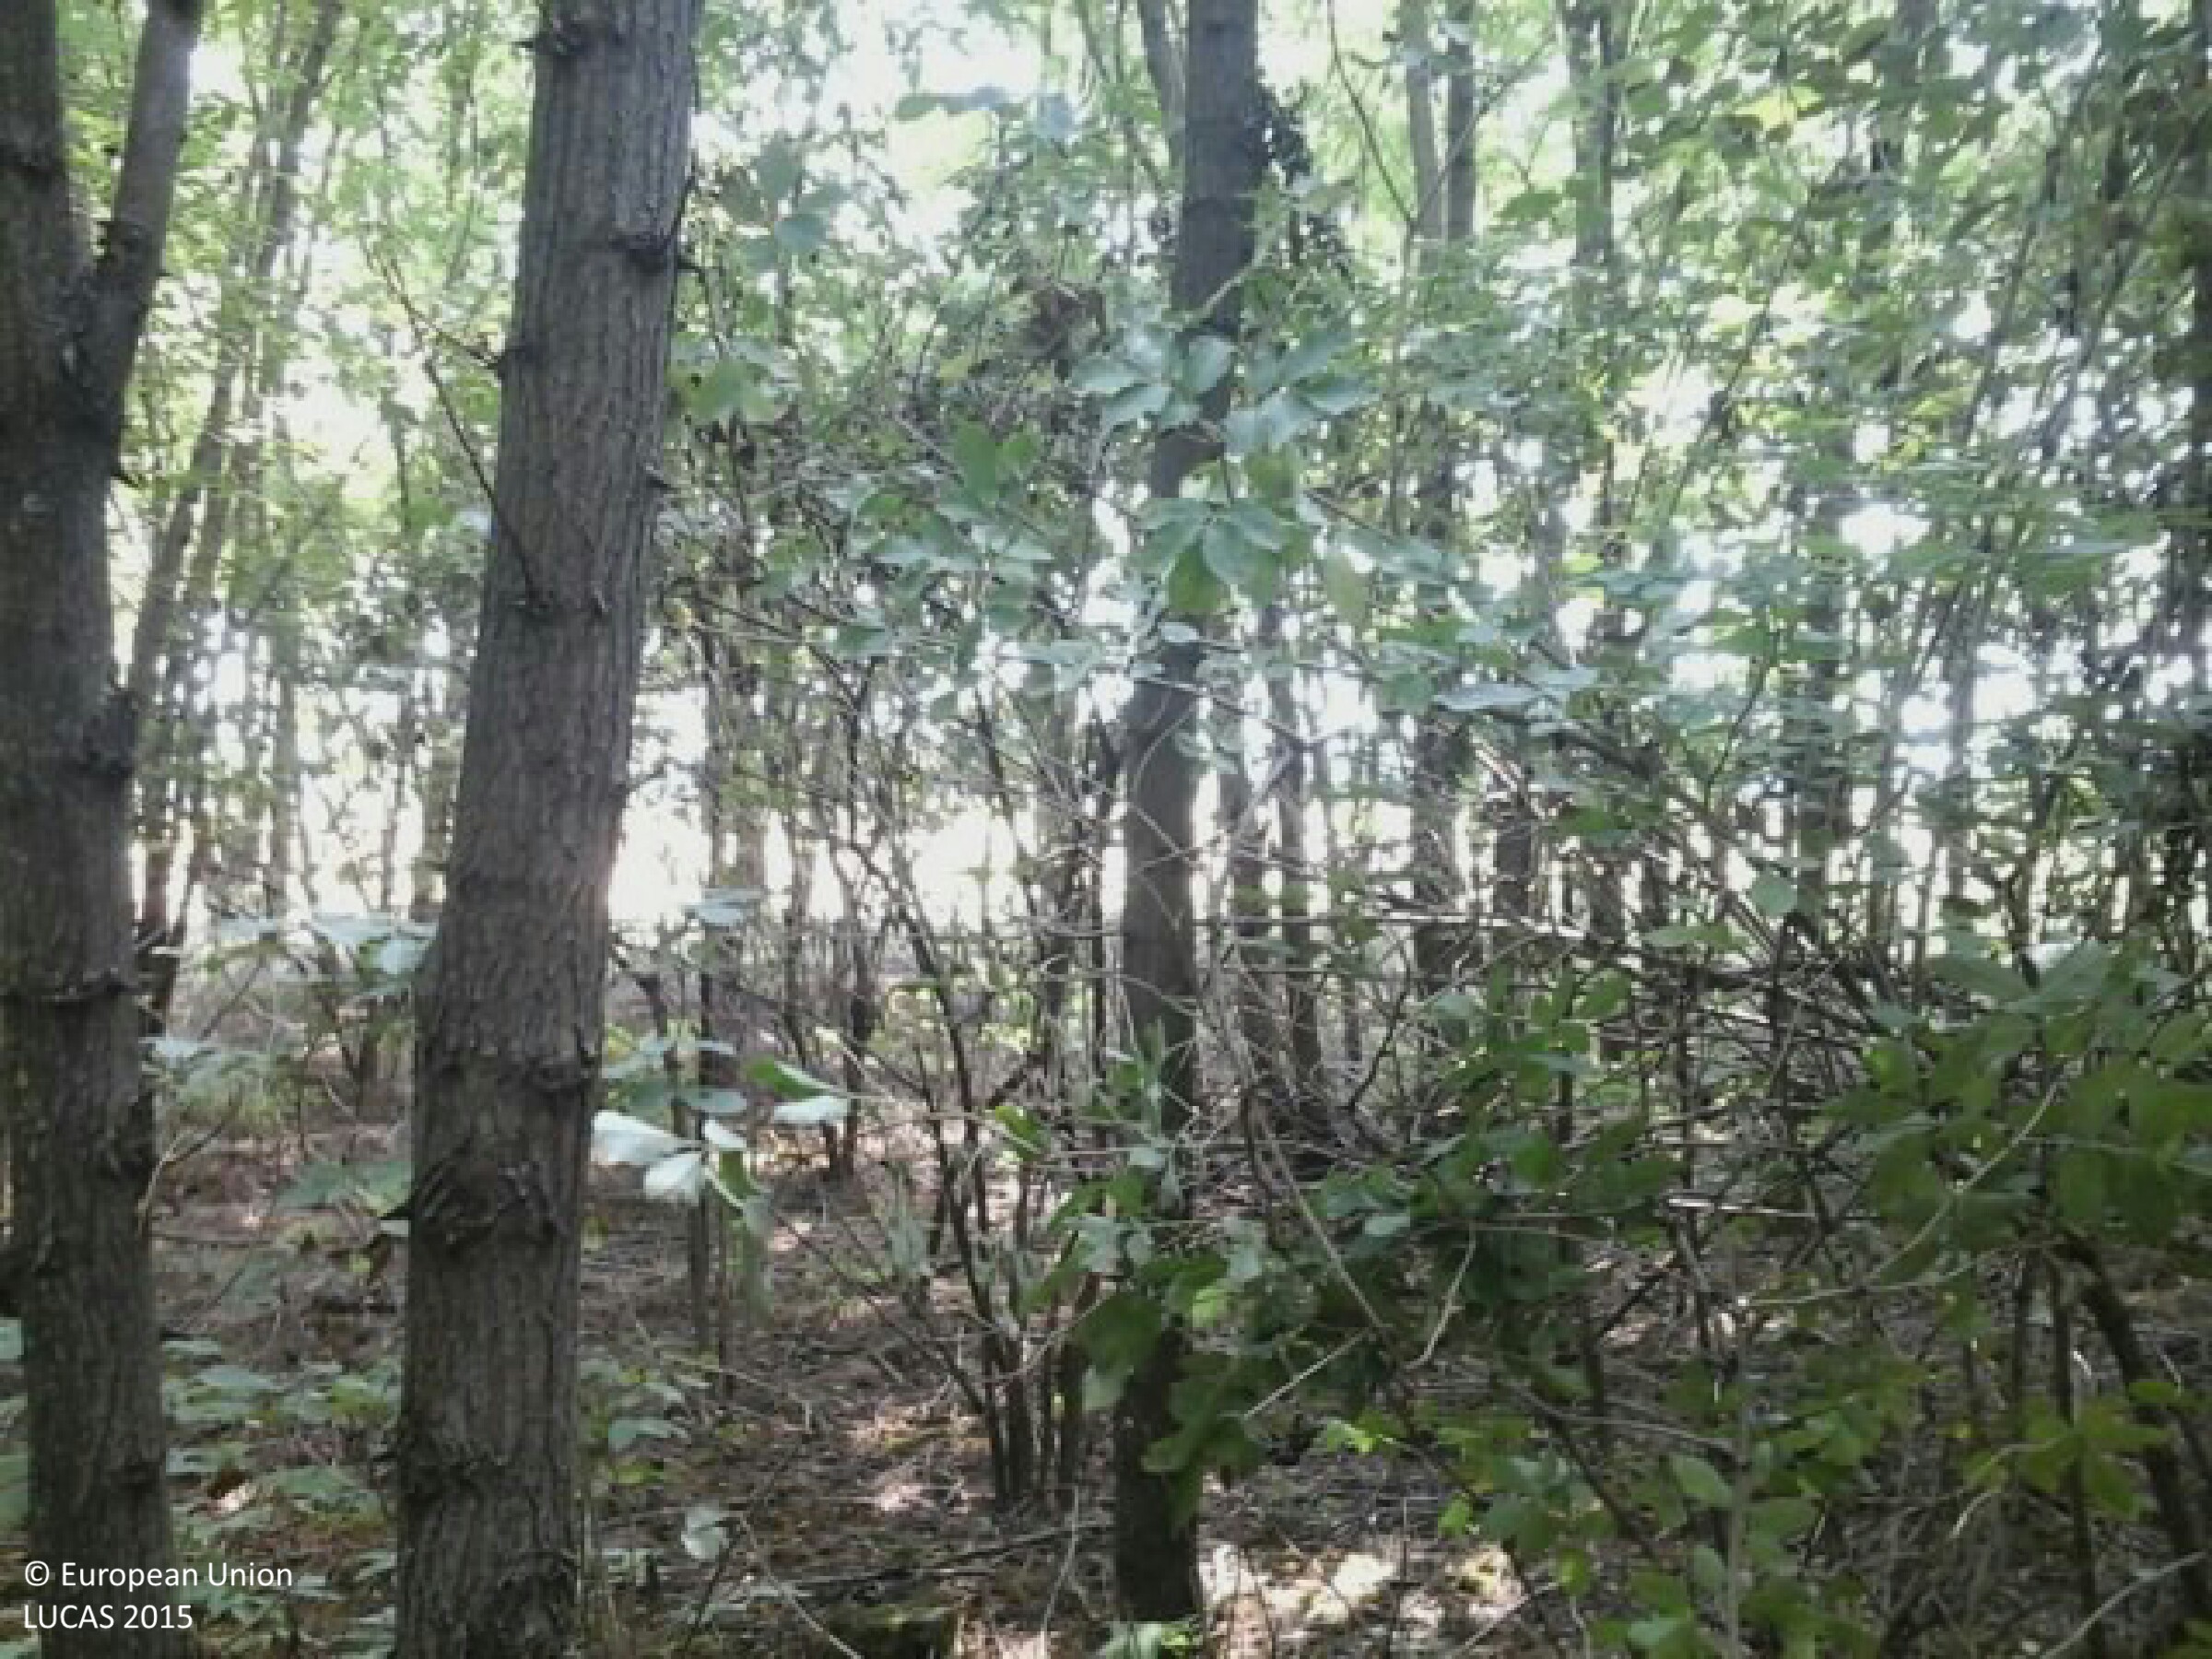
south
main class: Woodland
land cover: Broadleaved woodland
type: exotic forest
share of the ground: > 75 %
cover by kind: broadleaved forest trees 90 %, shrubs 5 %, herbaceous plants 5 %
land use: Forestry
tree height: > 5 m
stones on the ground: < 10 %
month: August
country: HU
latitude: 46.4145
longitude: 17.9821
